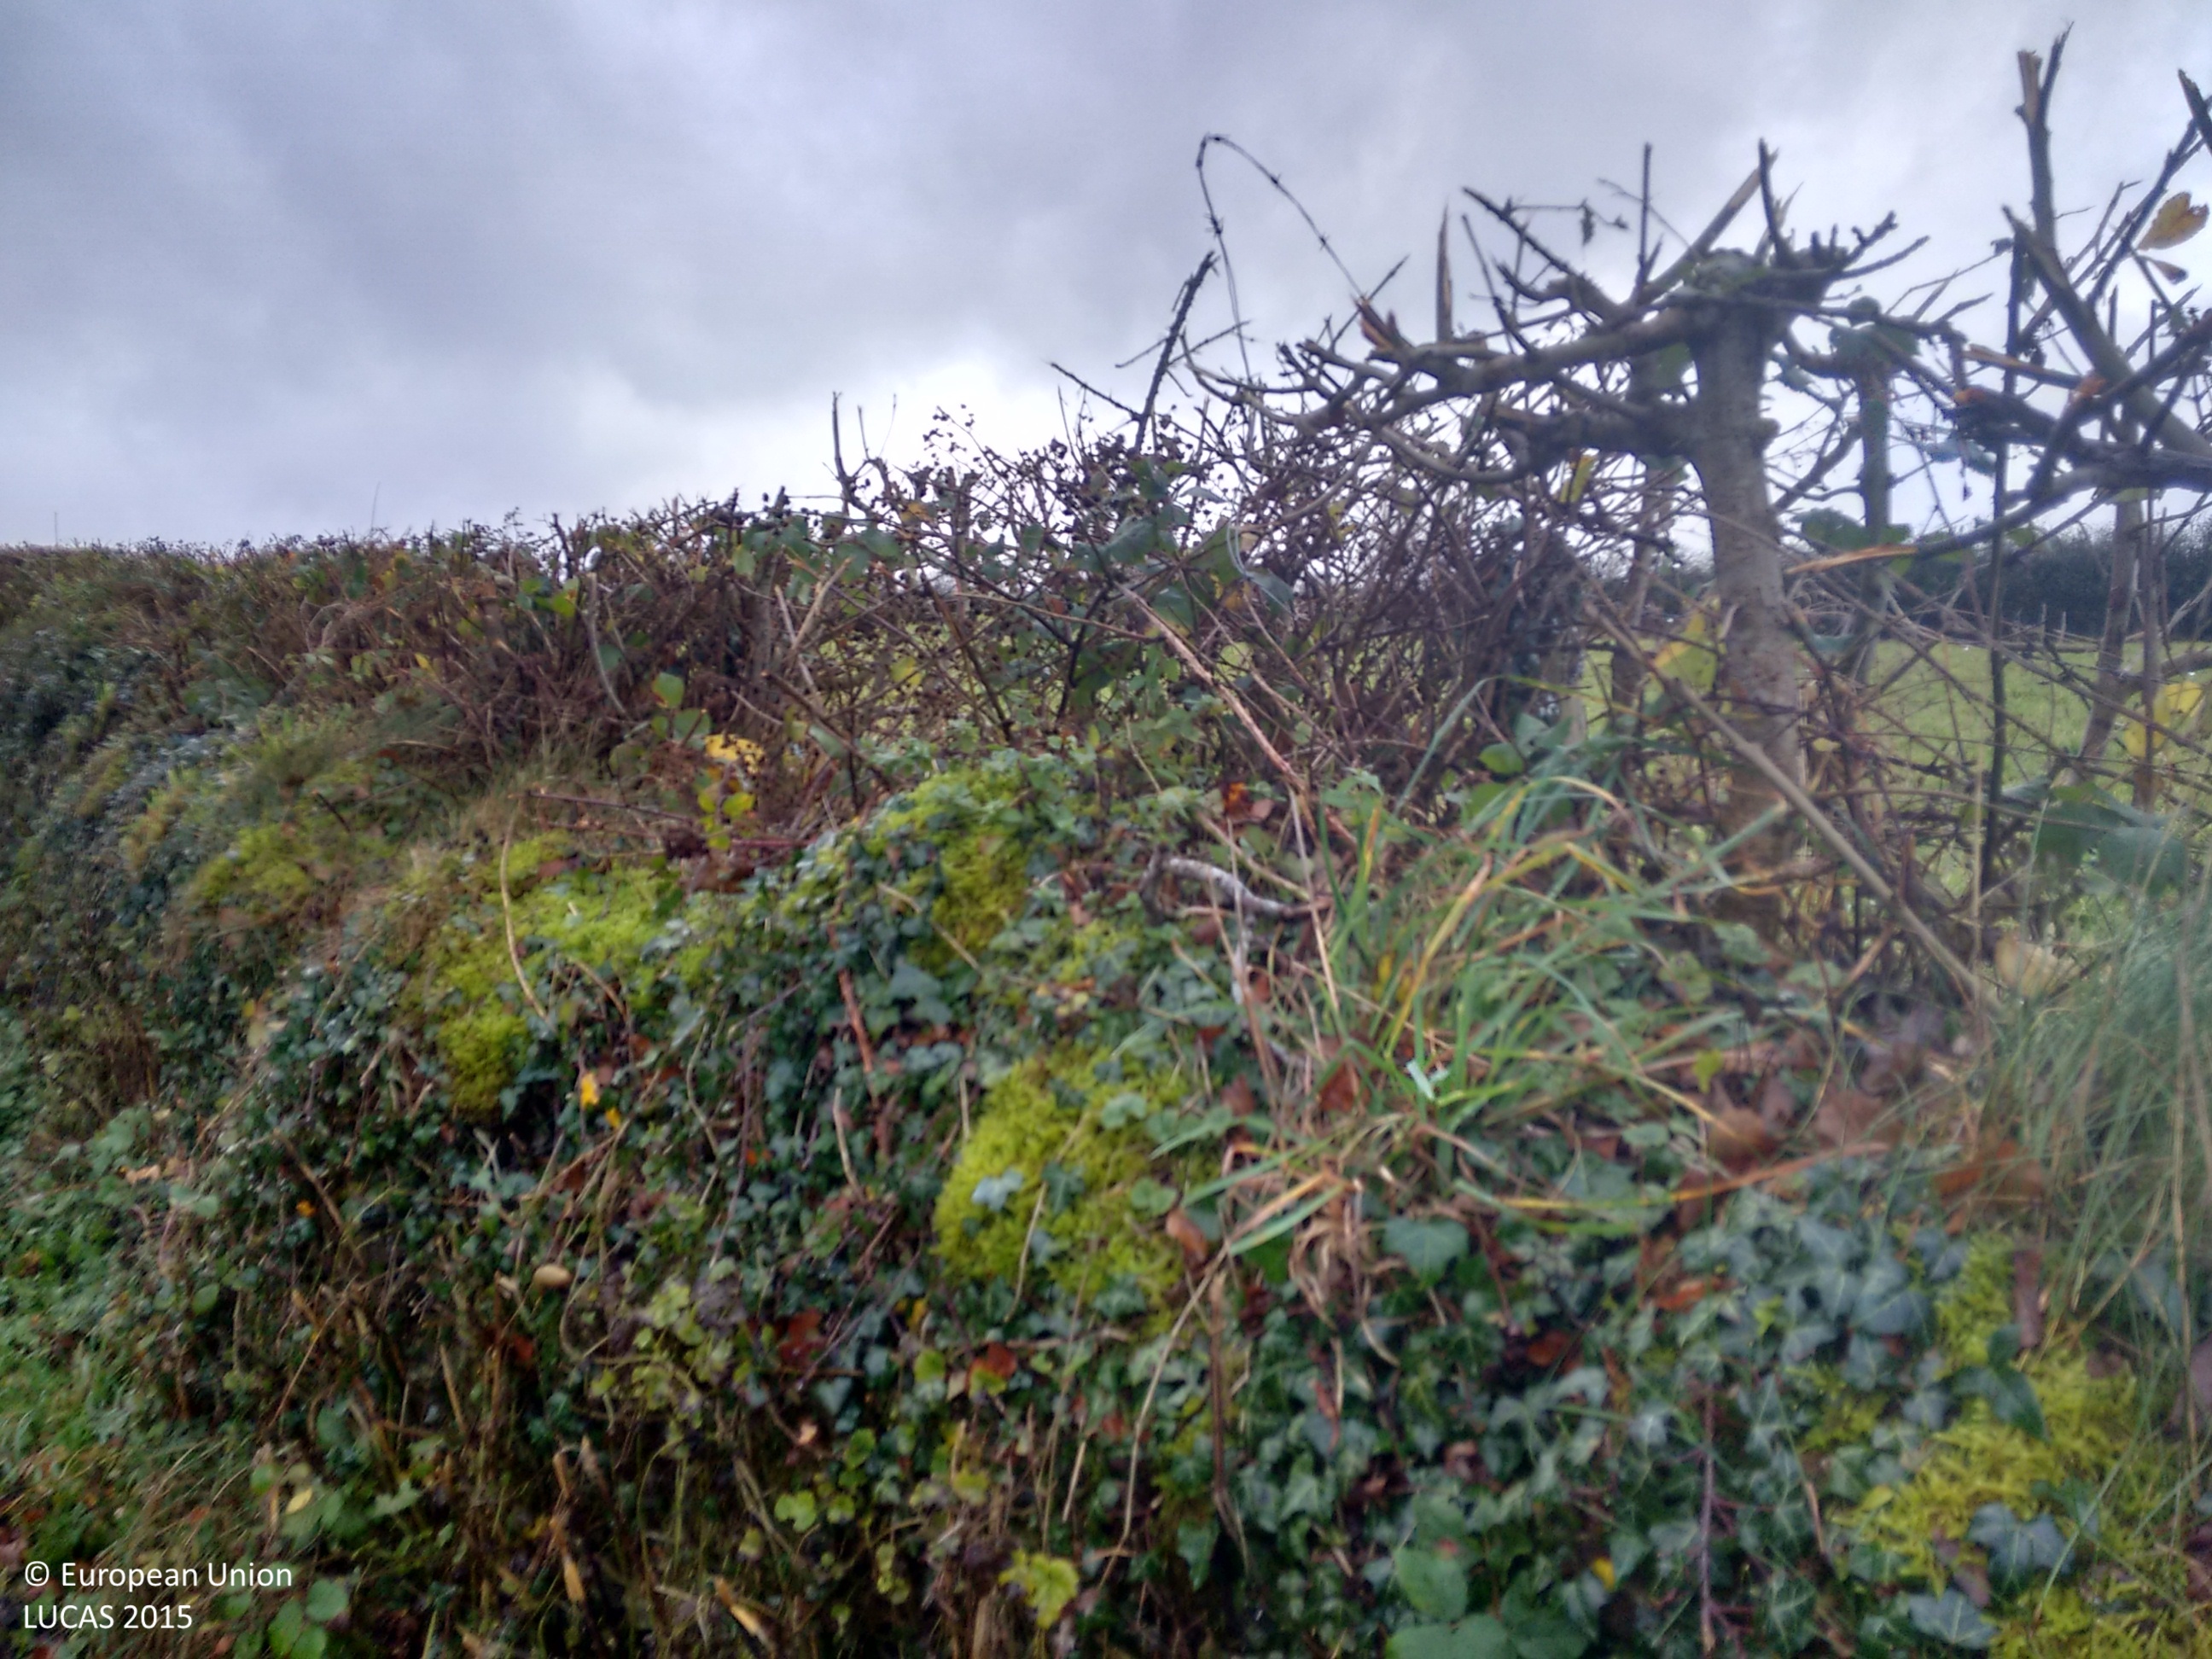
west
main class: Grassland
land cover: Grassland without tree/shrub cover
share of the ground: > 75 %
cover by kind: herbaceous plants 90 %, shrubs 5 %, consolidated bare surface 5 %
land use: Agriculture (excluding fallow land and kitchen gardens)
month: November
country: IE
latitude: 53.1292
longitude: -7.4794
